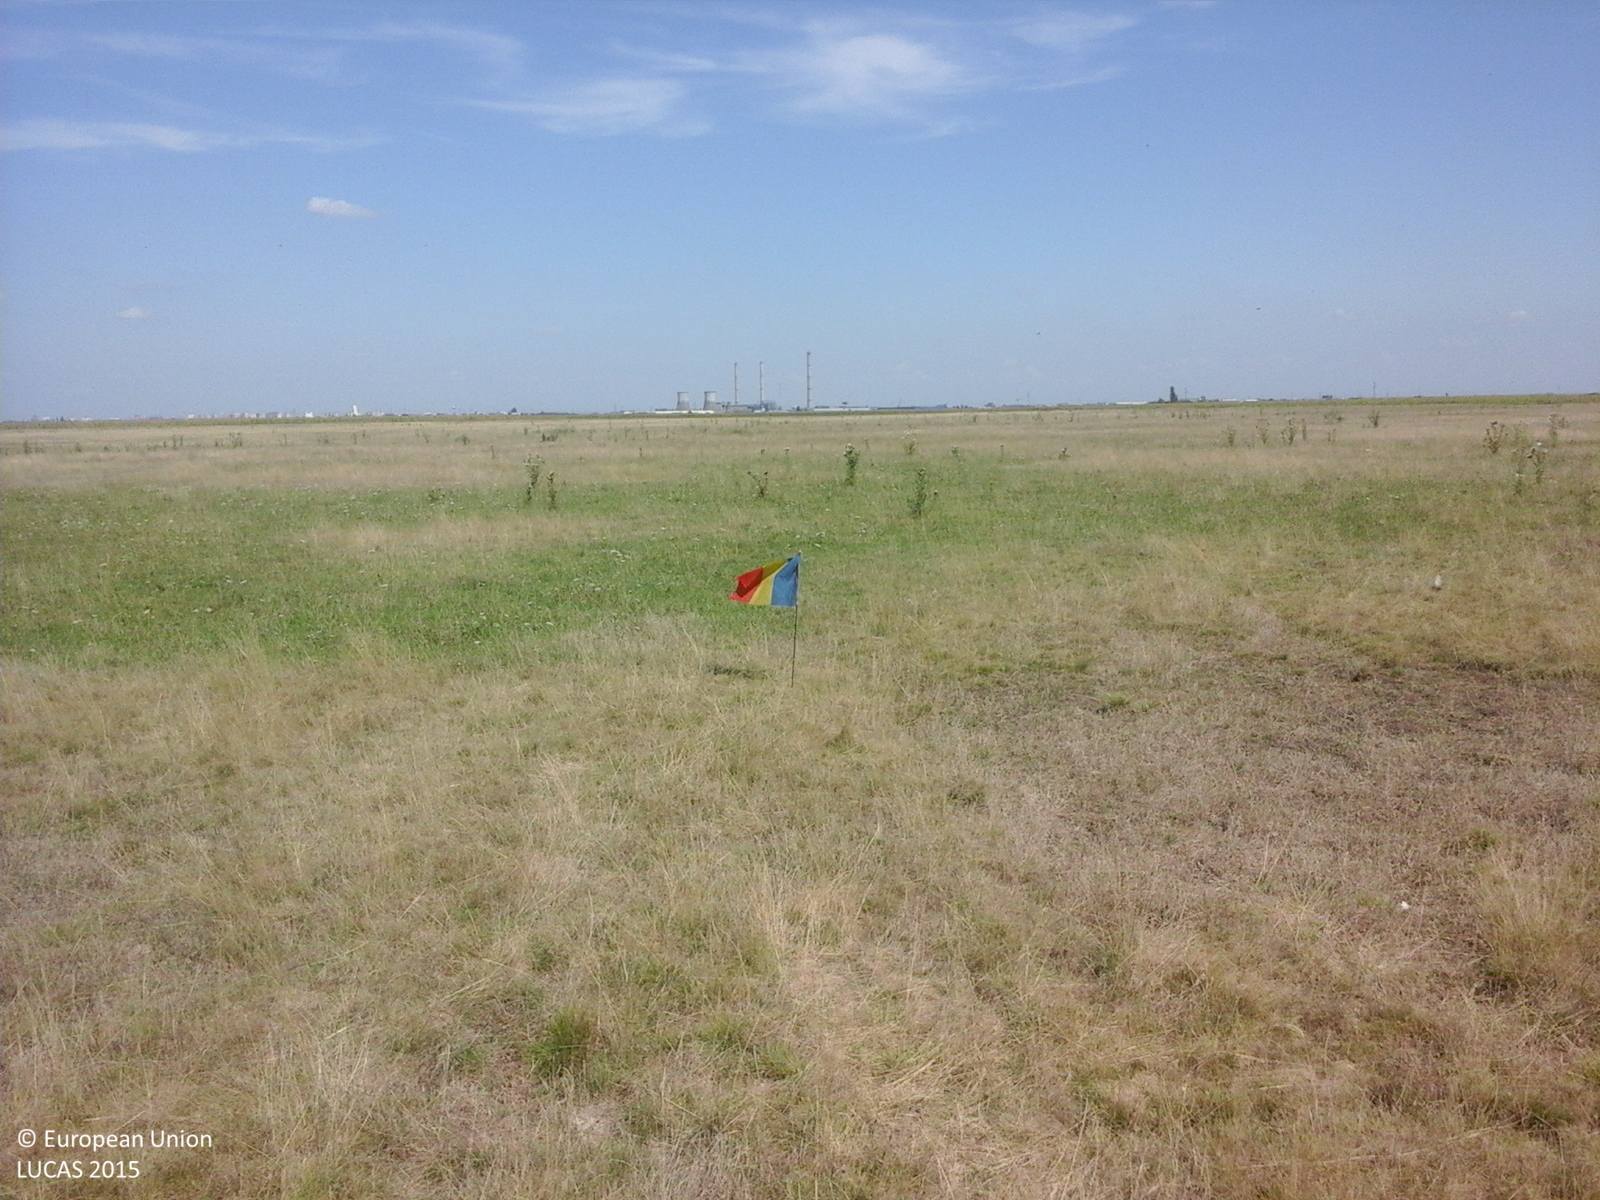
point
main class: Grassland
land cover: Grassland without tree/shrub cover
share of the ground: > 75 %
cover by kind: herbaceous plants 100 %
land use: Agriculture (excluding fallow land and kitchen gardens)
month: August
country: RO
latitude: 45.6949
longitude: 21.1376
